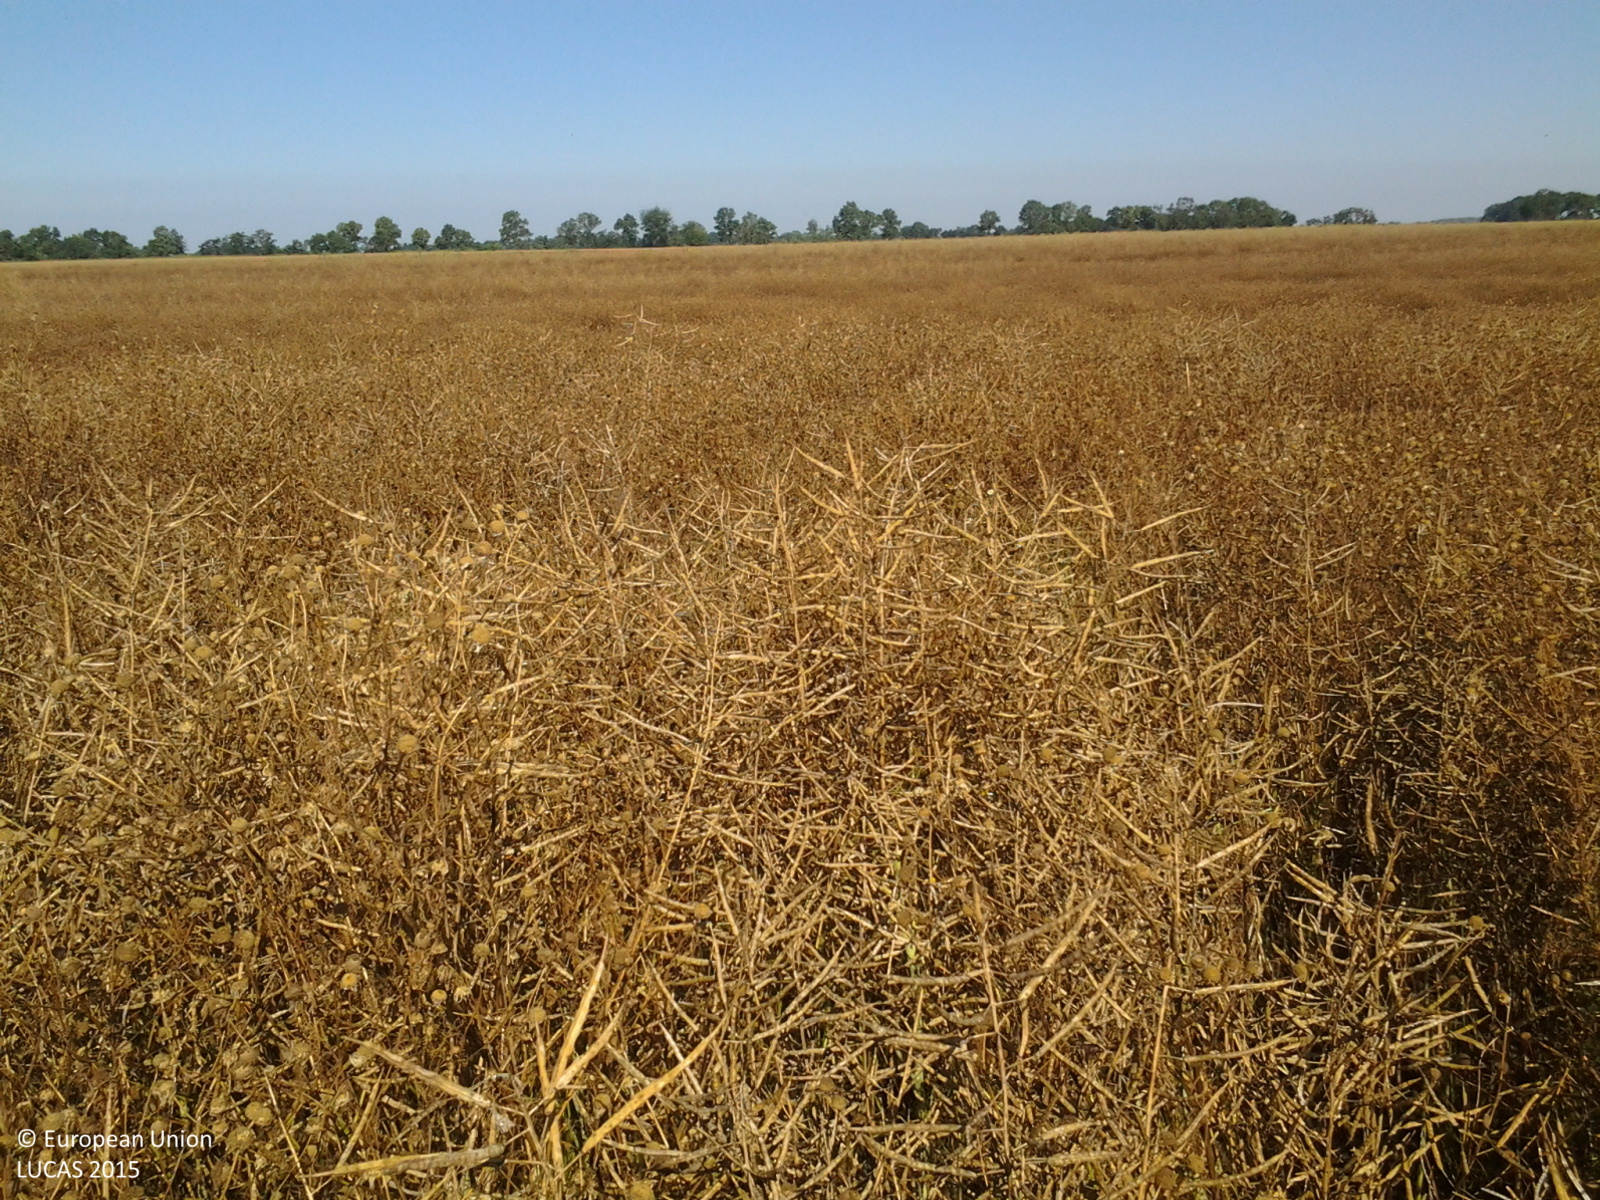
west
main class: Cropland
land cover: Rape and turnip rape
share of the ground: > 75 %
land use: Agriculture (excluding fallow land and kitchen gardens)
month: July
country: HU
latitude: 47.0168
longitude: 20.4606
